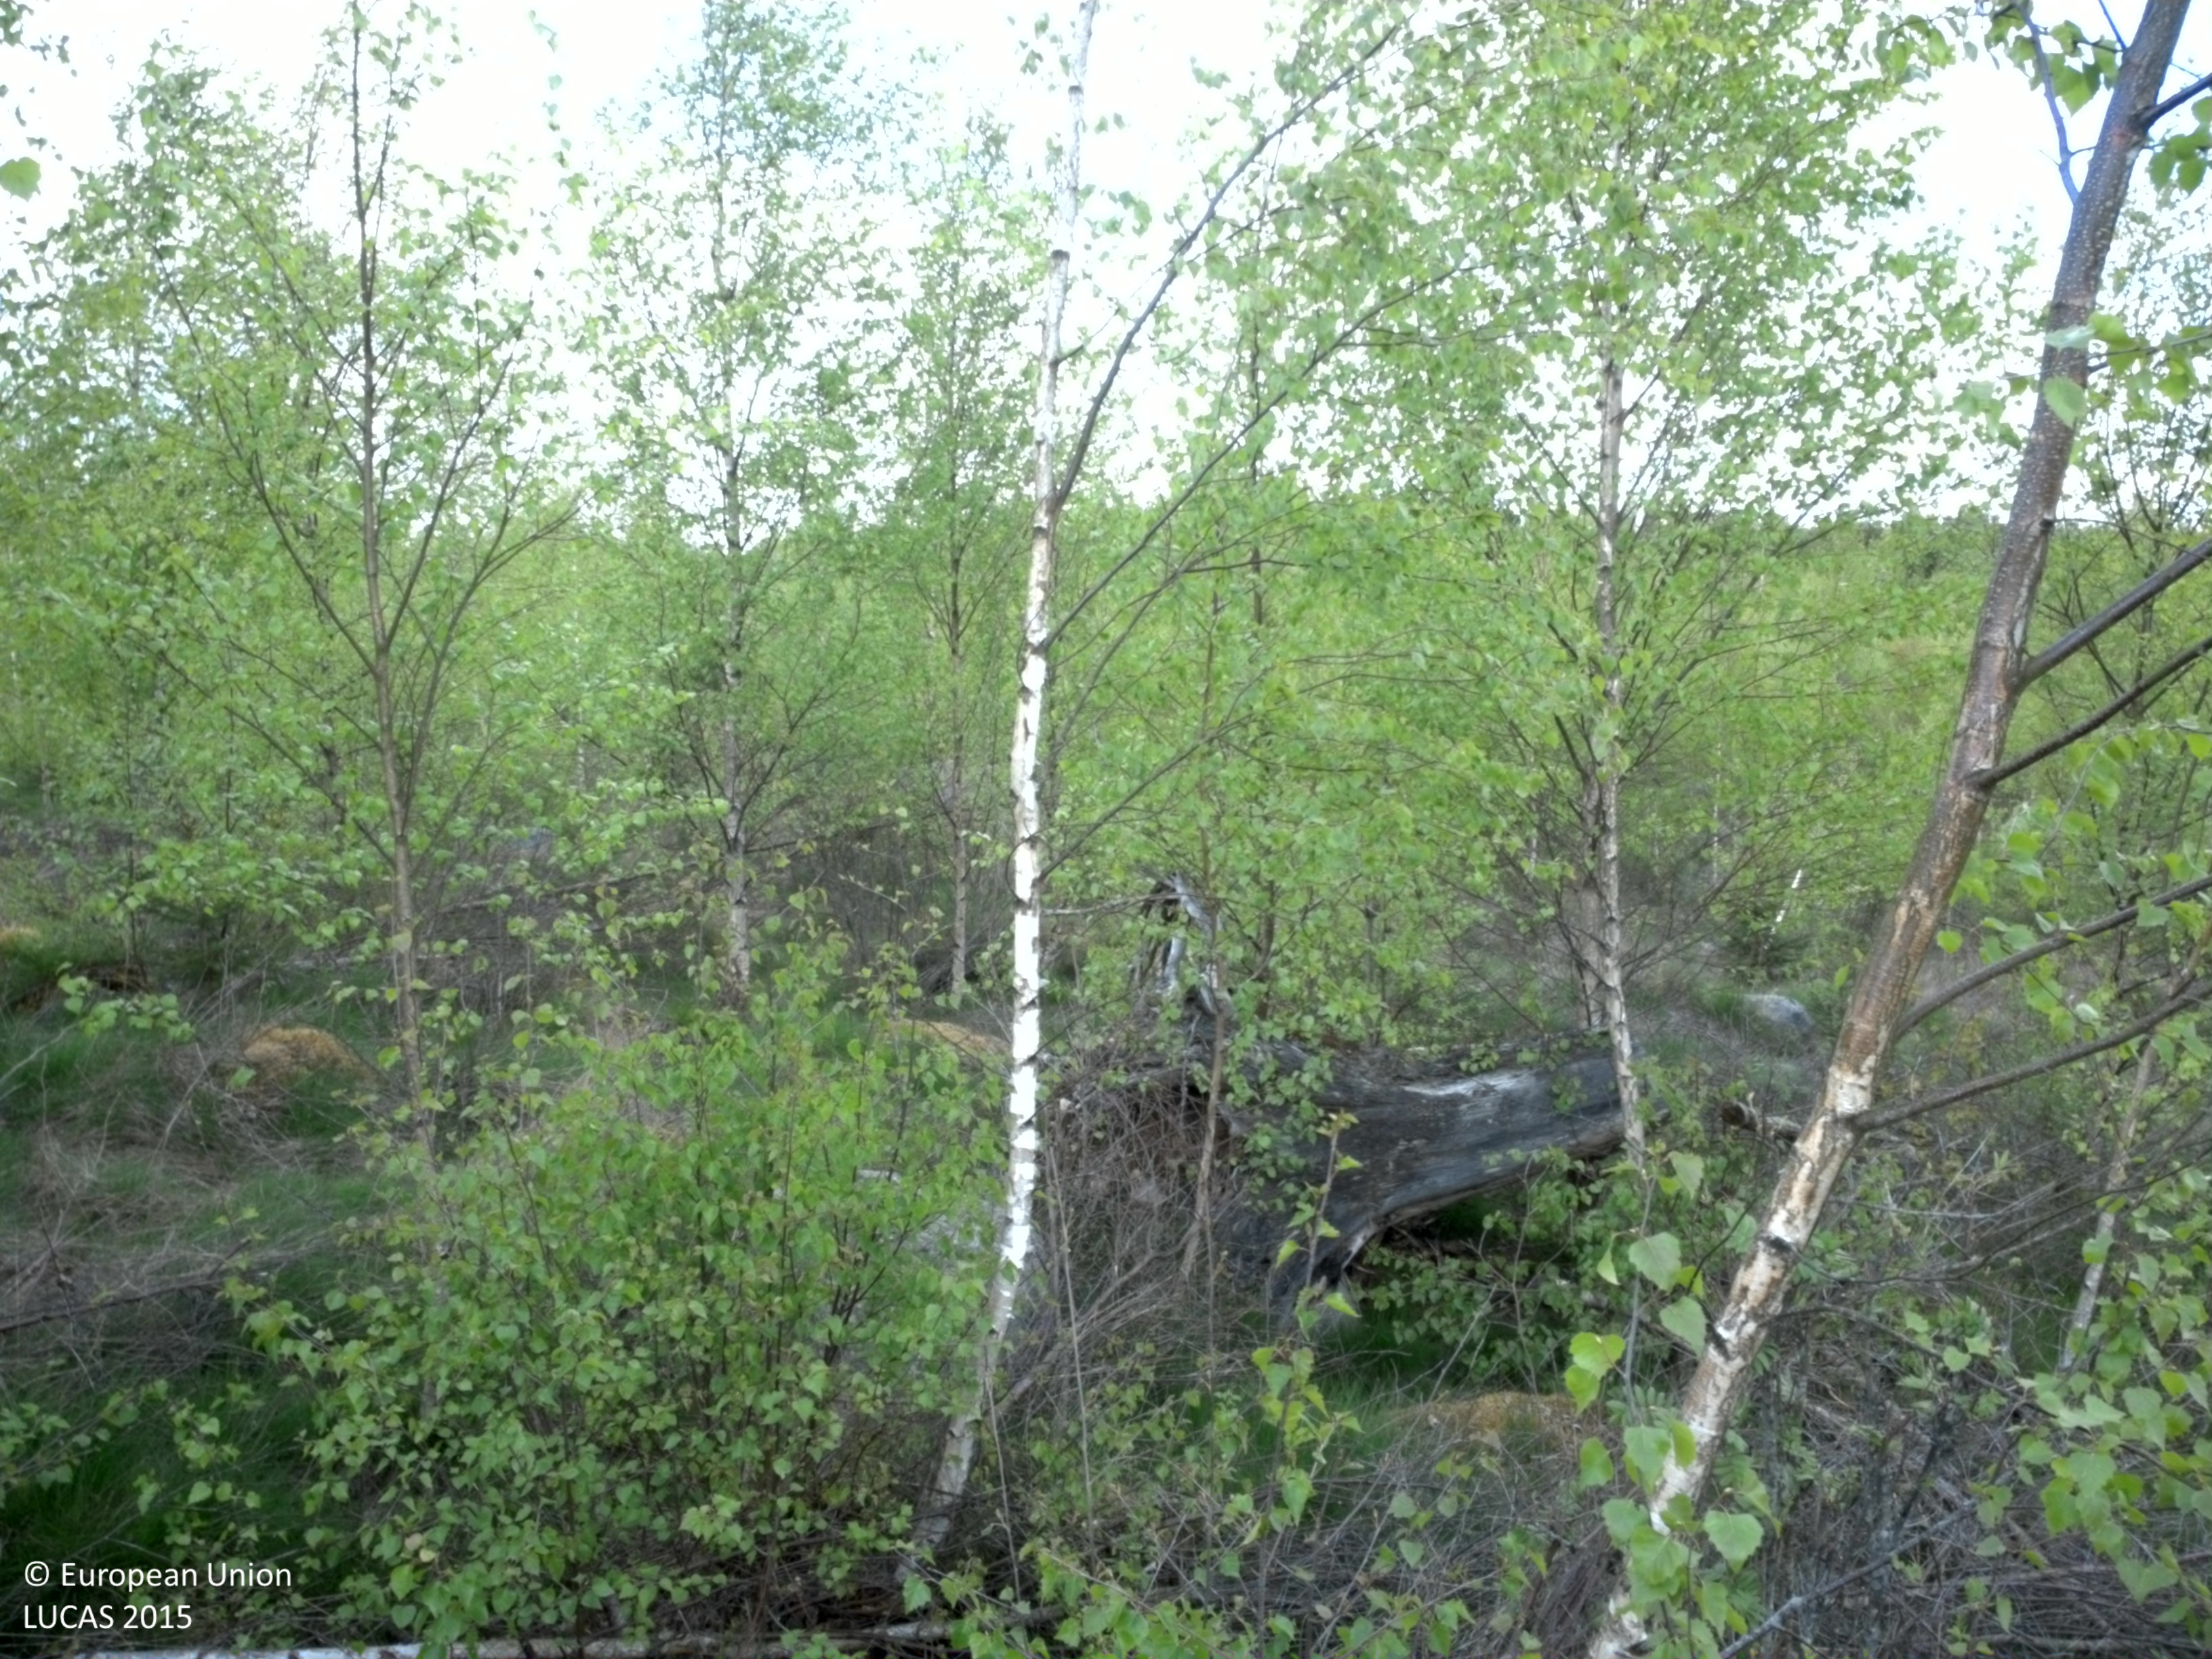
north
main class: Woodland
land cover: Broadleaved woodland
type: boreal forest
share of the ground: 50 - 75 %
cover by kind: broadleaved forest trees 60 %, herbaceous plants 30 %, coniferous forest trees 10 %
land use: Forestry
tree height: > 5 m
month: May
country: SE
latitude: 56.7036
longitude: 14.4887
